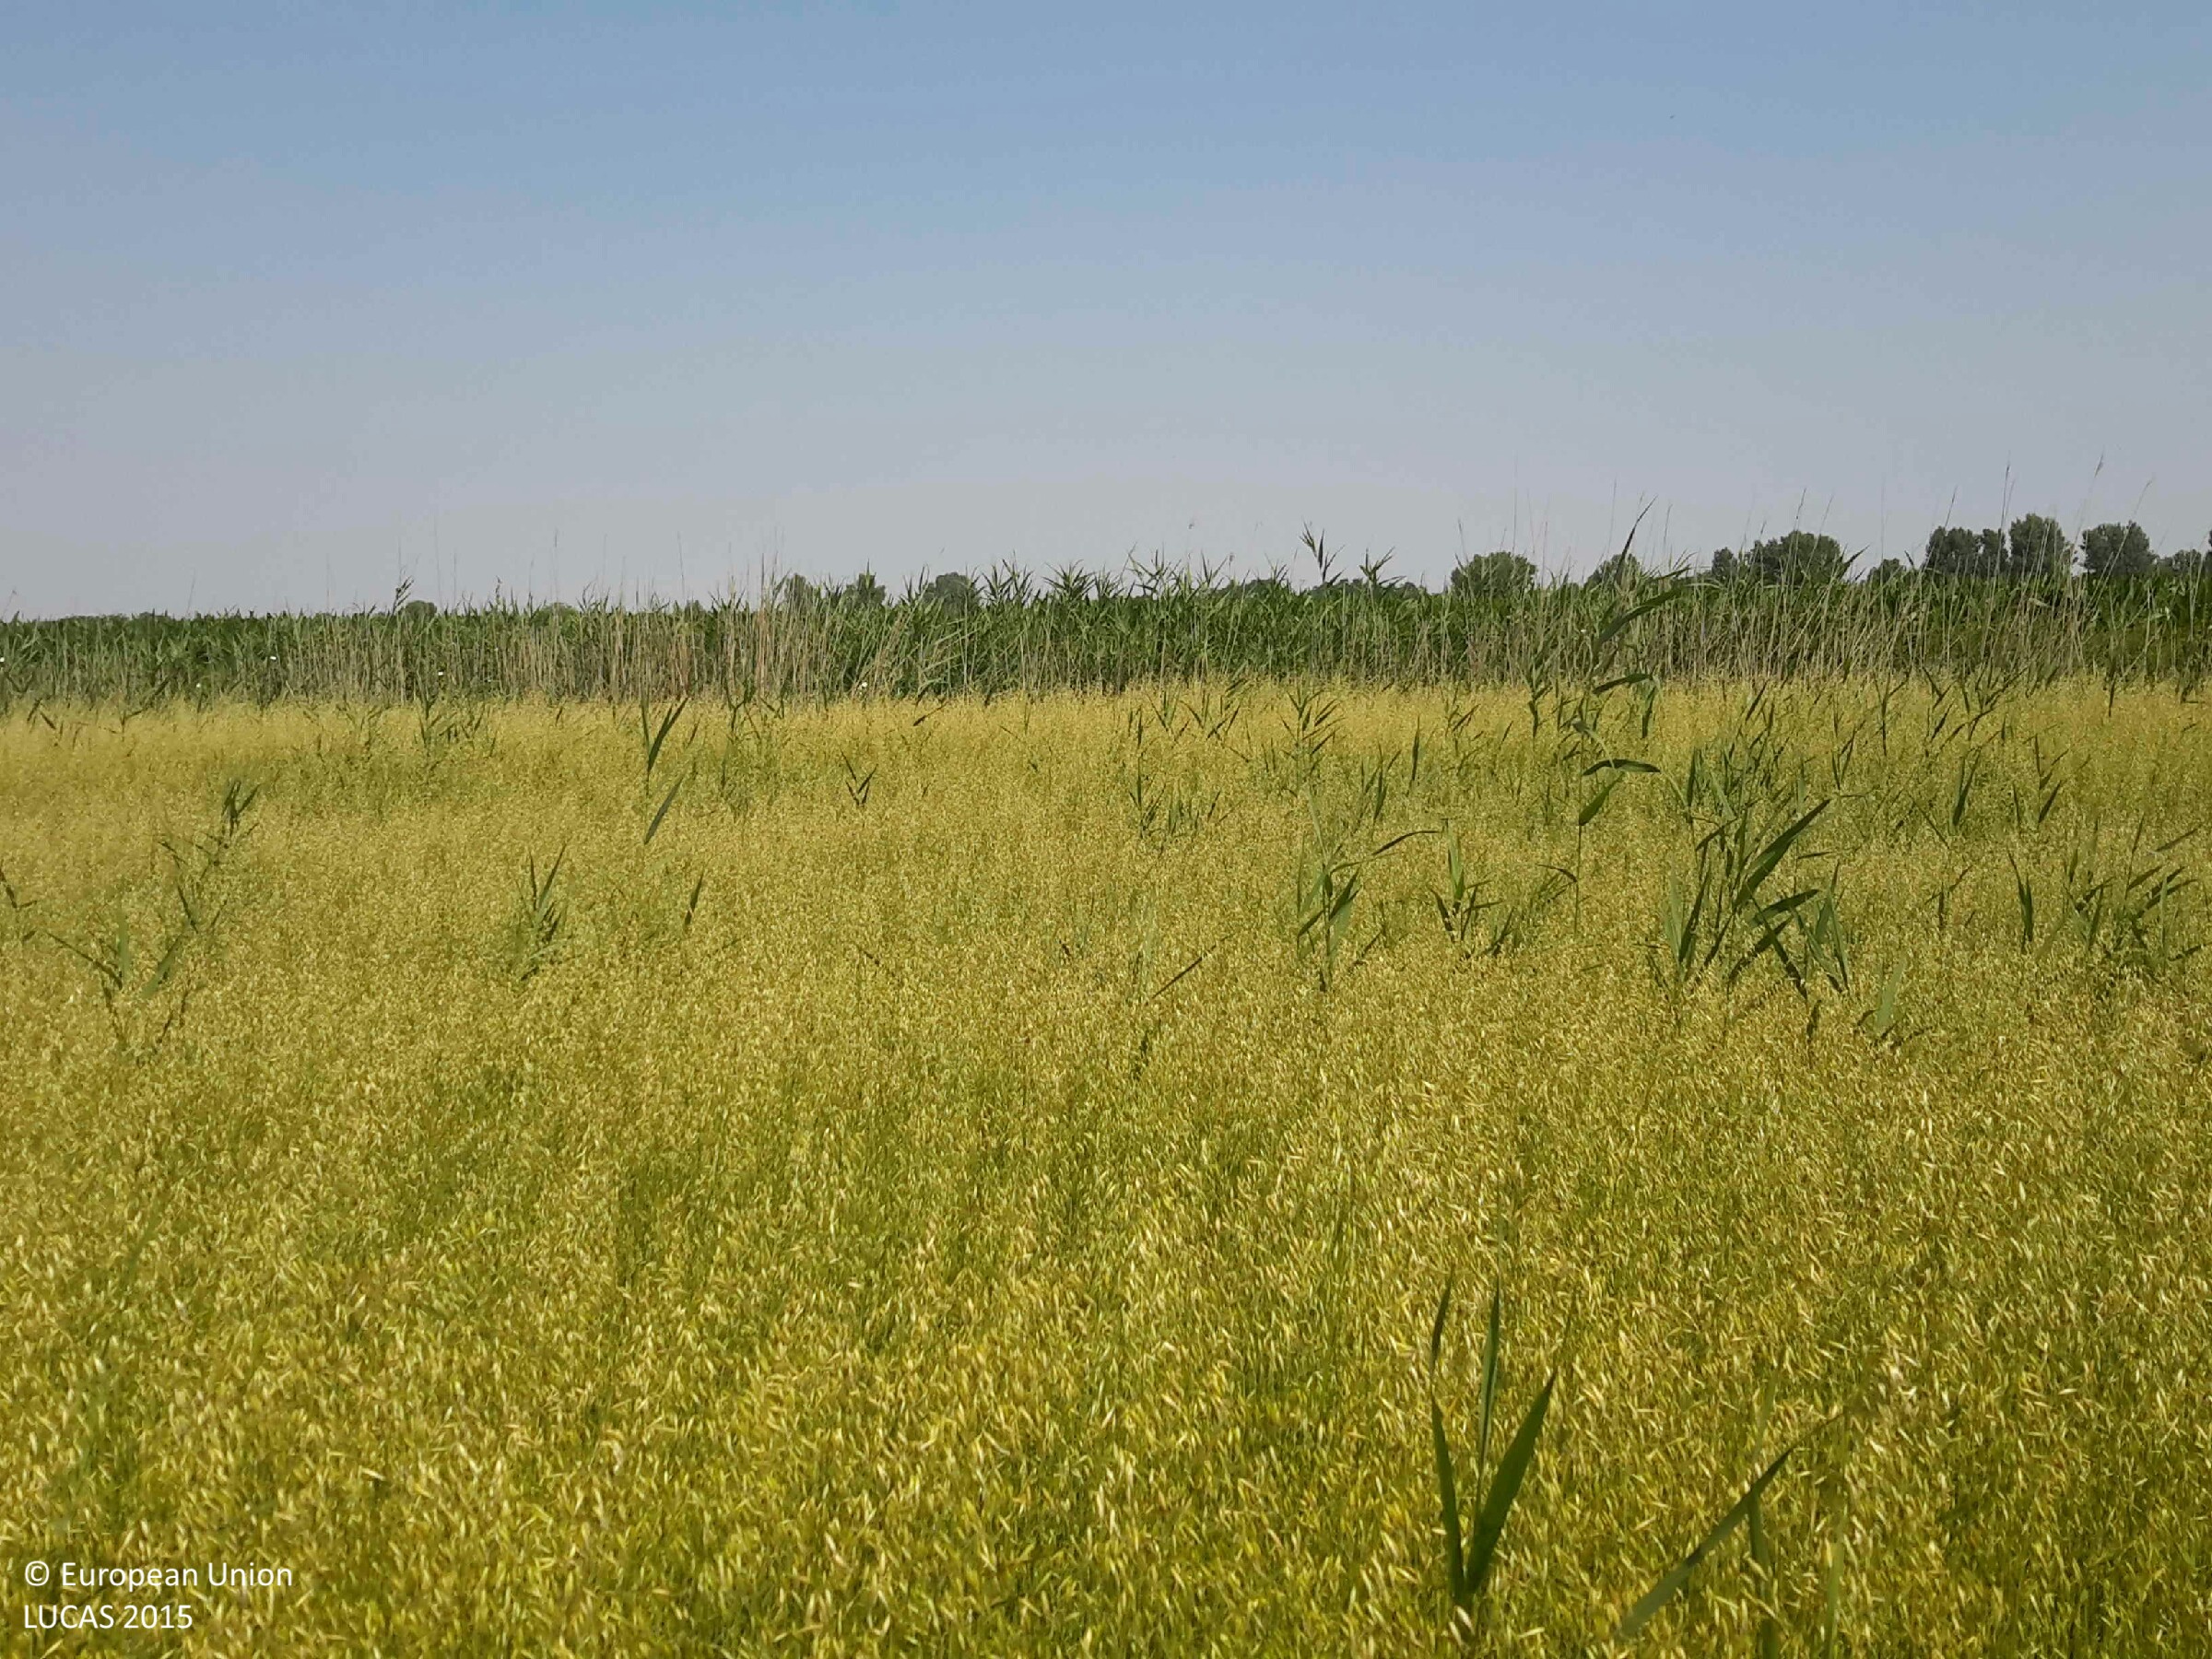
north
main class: Cropland
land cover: Oats
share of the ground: > 75 %
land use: Agriculture (excluding fallow land and kitchen gardens)
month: July
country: HU
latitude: 47.4079
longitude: 17.4952
